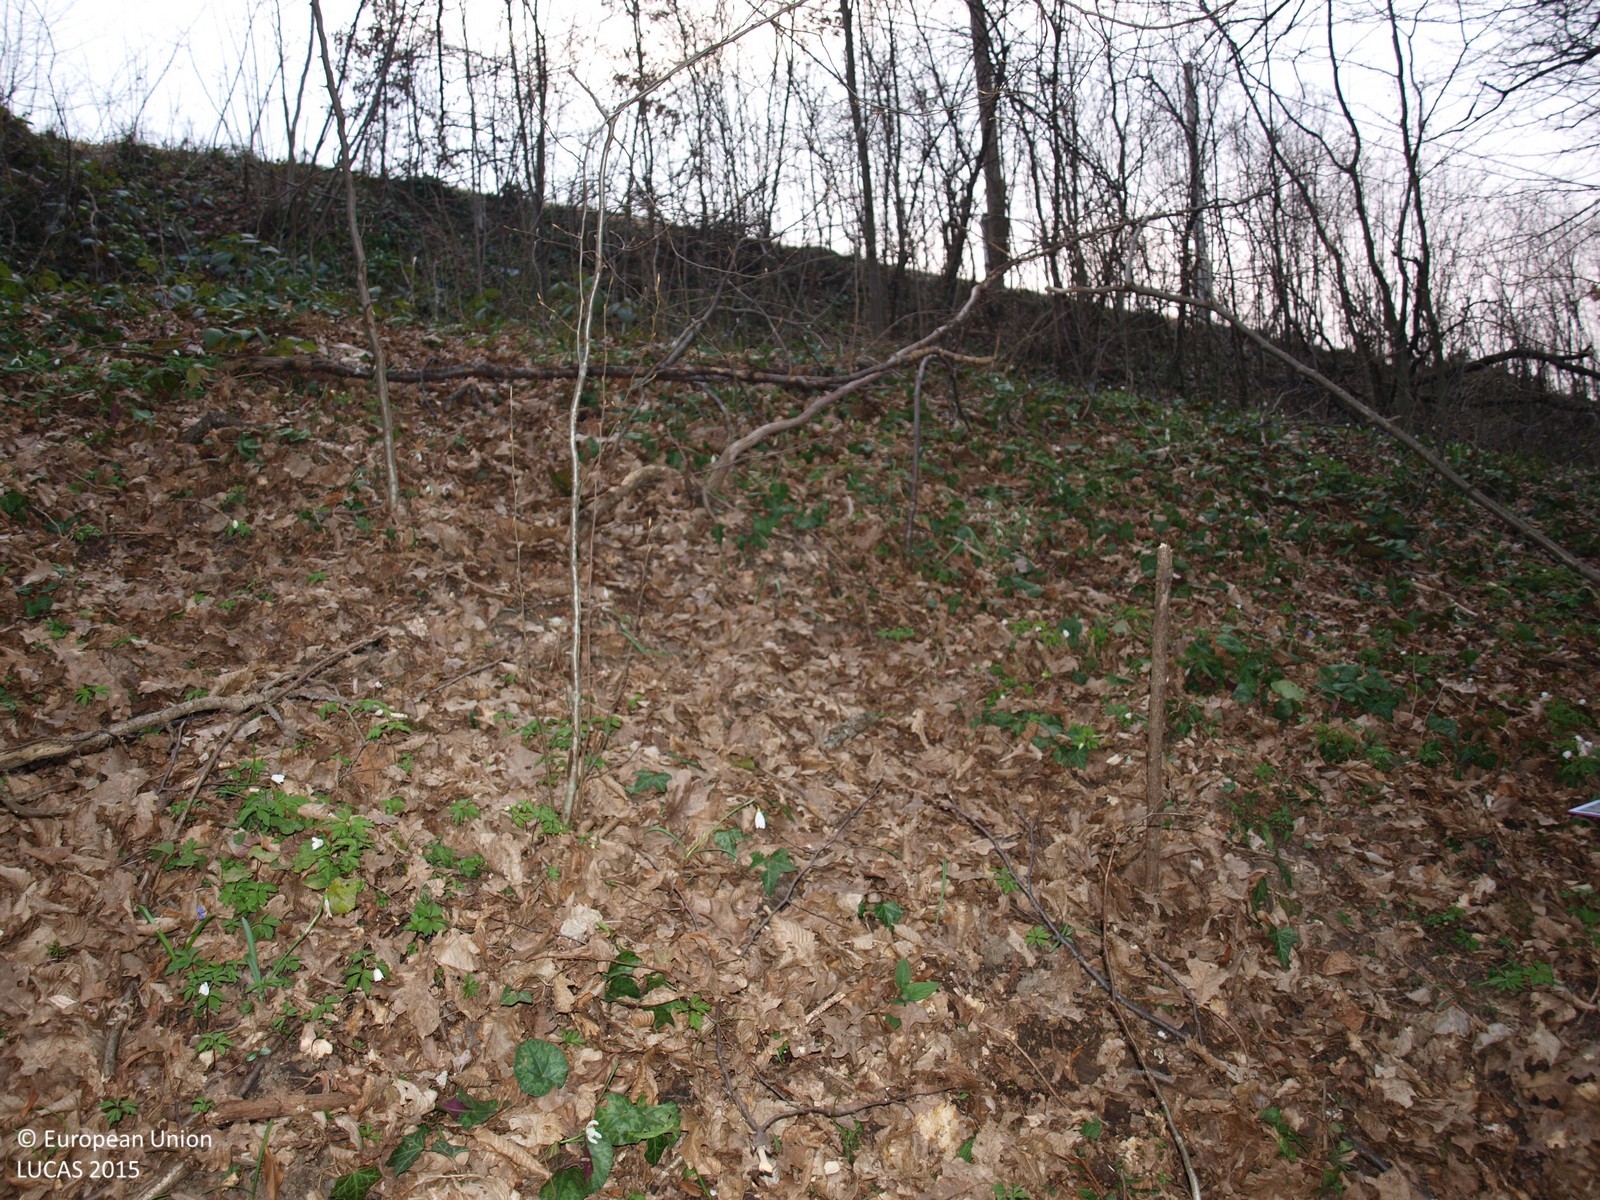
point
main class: Woodland
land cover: Broadleaved woodland
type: mesophytic deciduous forest
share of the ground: > 75 %
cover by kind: broadleaved forest trees 100 %
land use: Forestry
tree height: > 5 m
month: March
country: HR
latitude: 46.2203
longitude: 15.9754
